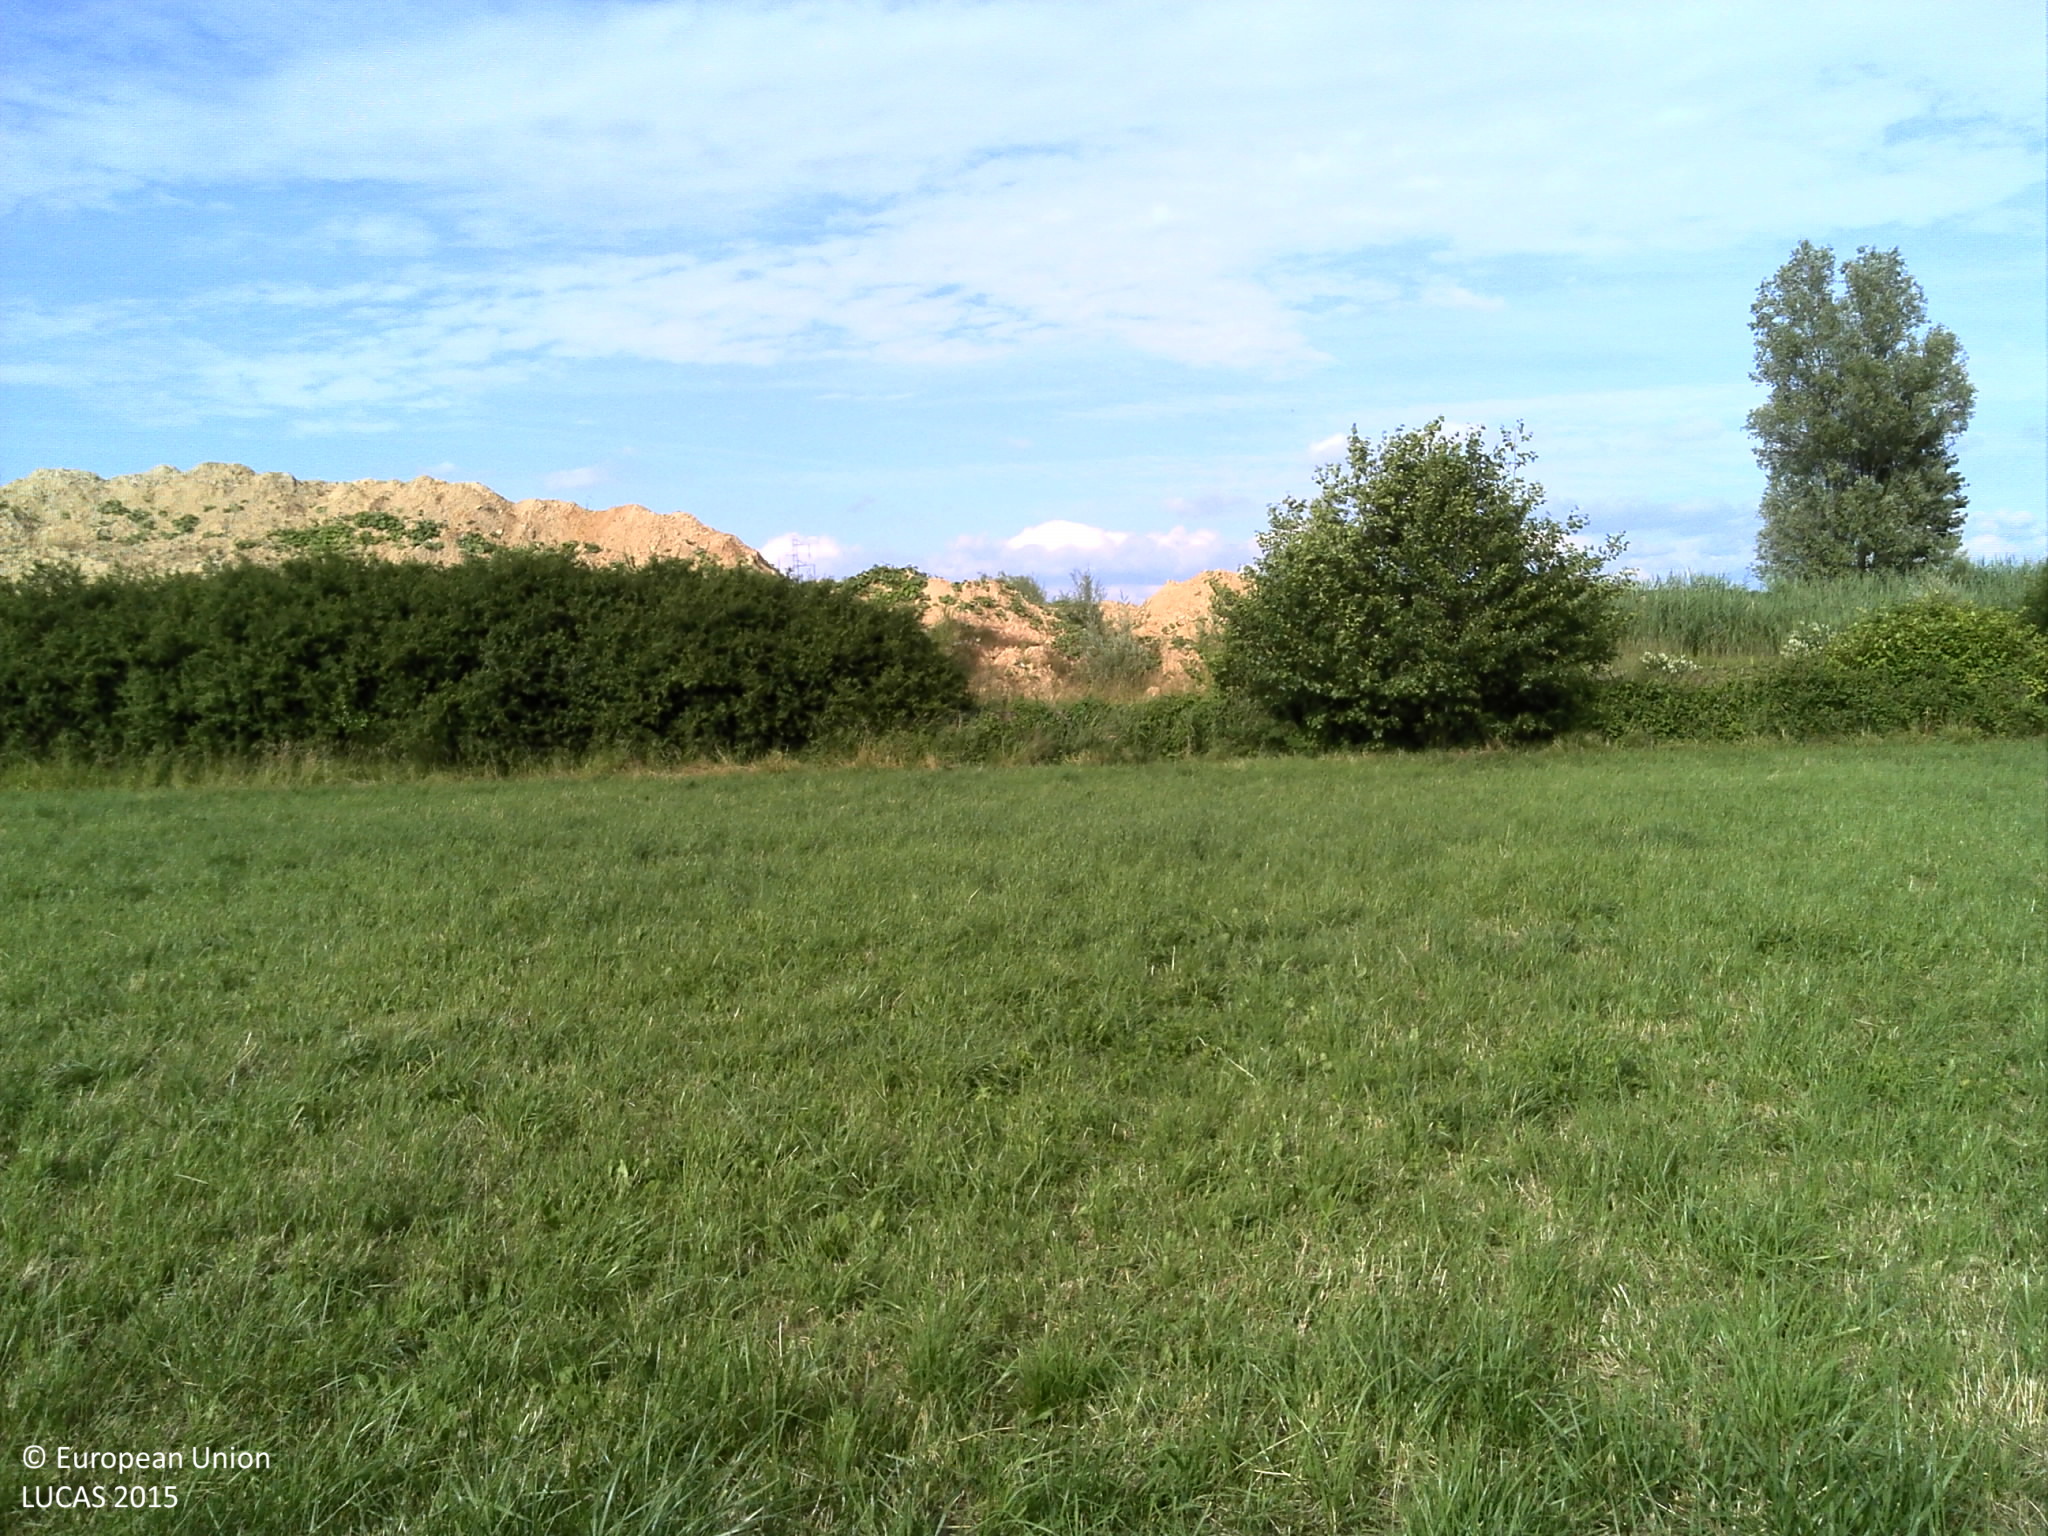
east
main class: Grassland
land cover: Grassland without tree/shrub cover
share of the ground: > 75 %
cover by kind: herbaceous plants 100 %
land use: Agriculture (excluding fallow land and kitchen gardens)
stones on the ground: < 10 %
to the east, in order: Grassland without tree/shrub cover; Fences; Abandoned hedges; Spontaneously vegetated surfaces; Sand; Inland marshes
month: June
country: FR
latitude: 49.7218
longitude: 4.7675
